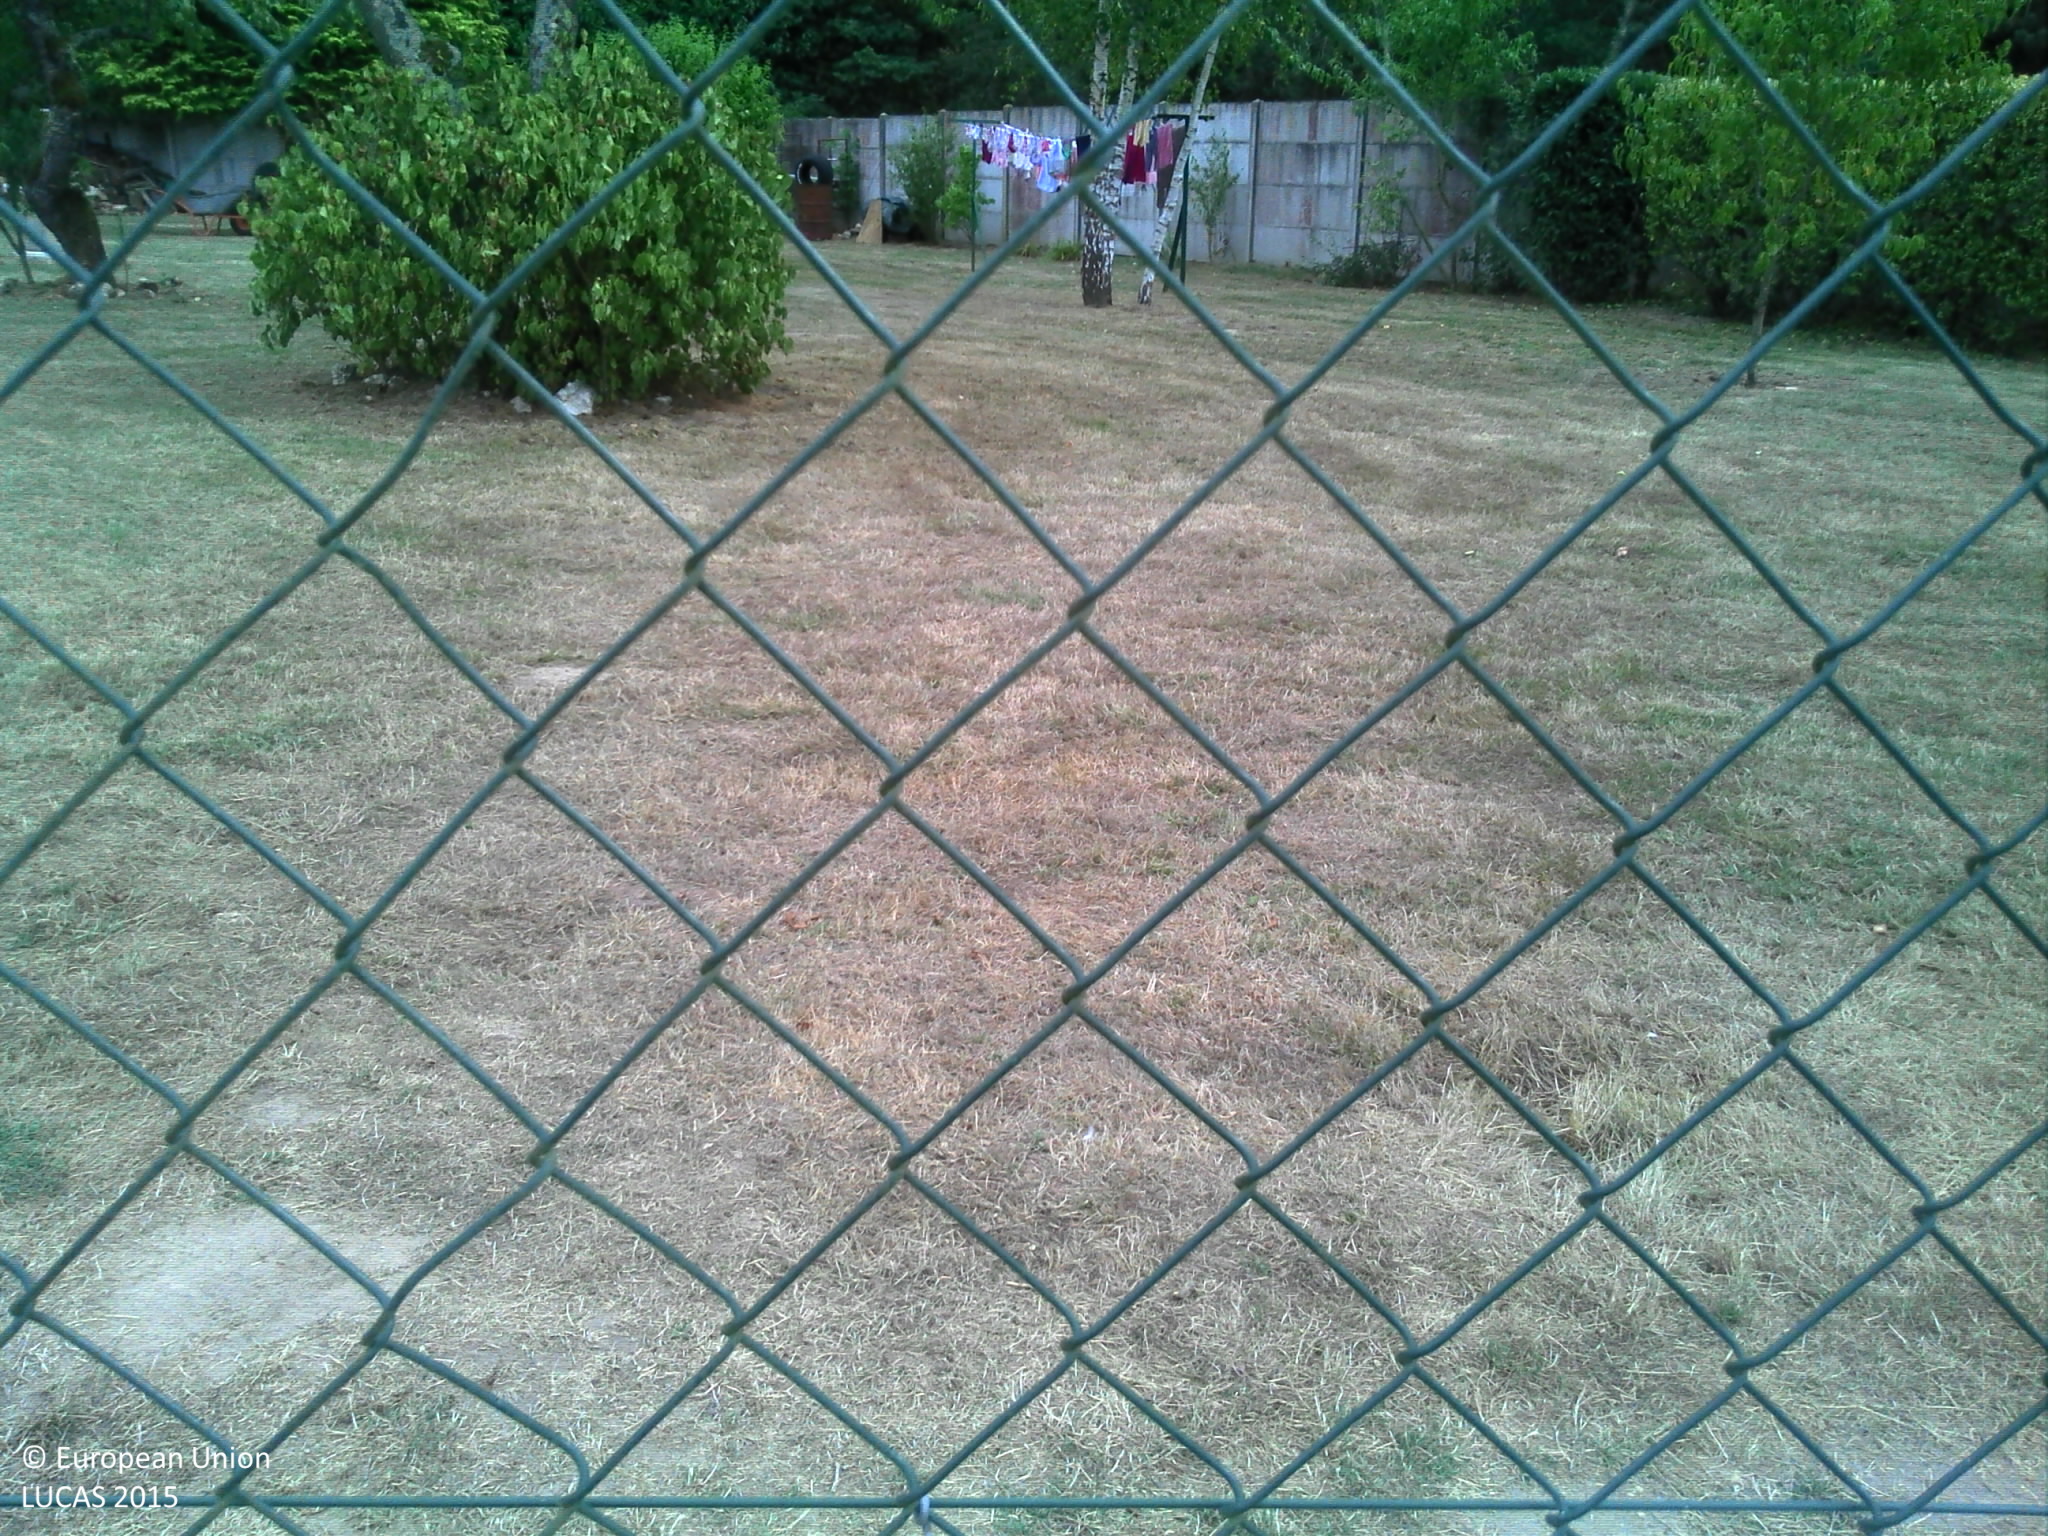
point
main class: Grassland
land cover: Grassland with sparse tree/shrub cover
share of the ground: > 75 %
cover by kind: herbaceous plants 95 %, broadleaved forest trees 5 %
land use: Residential
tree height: > 5 m
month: August
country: FR
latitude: 48.0434
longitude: 2.0334
